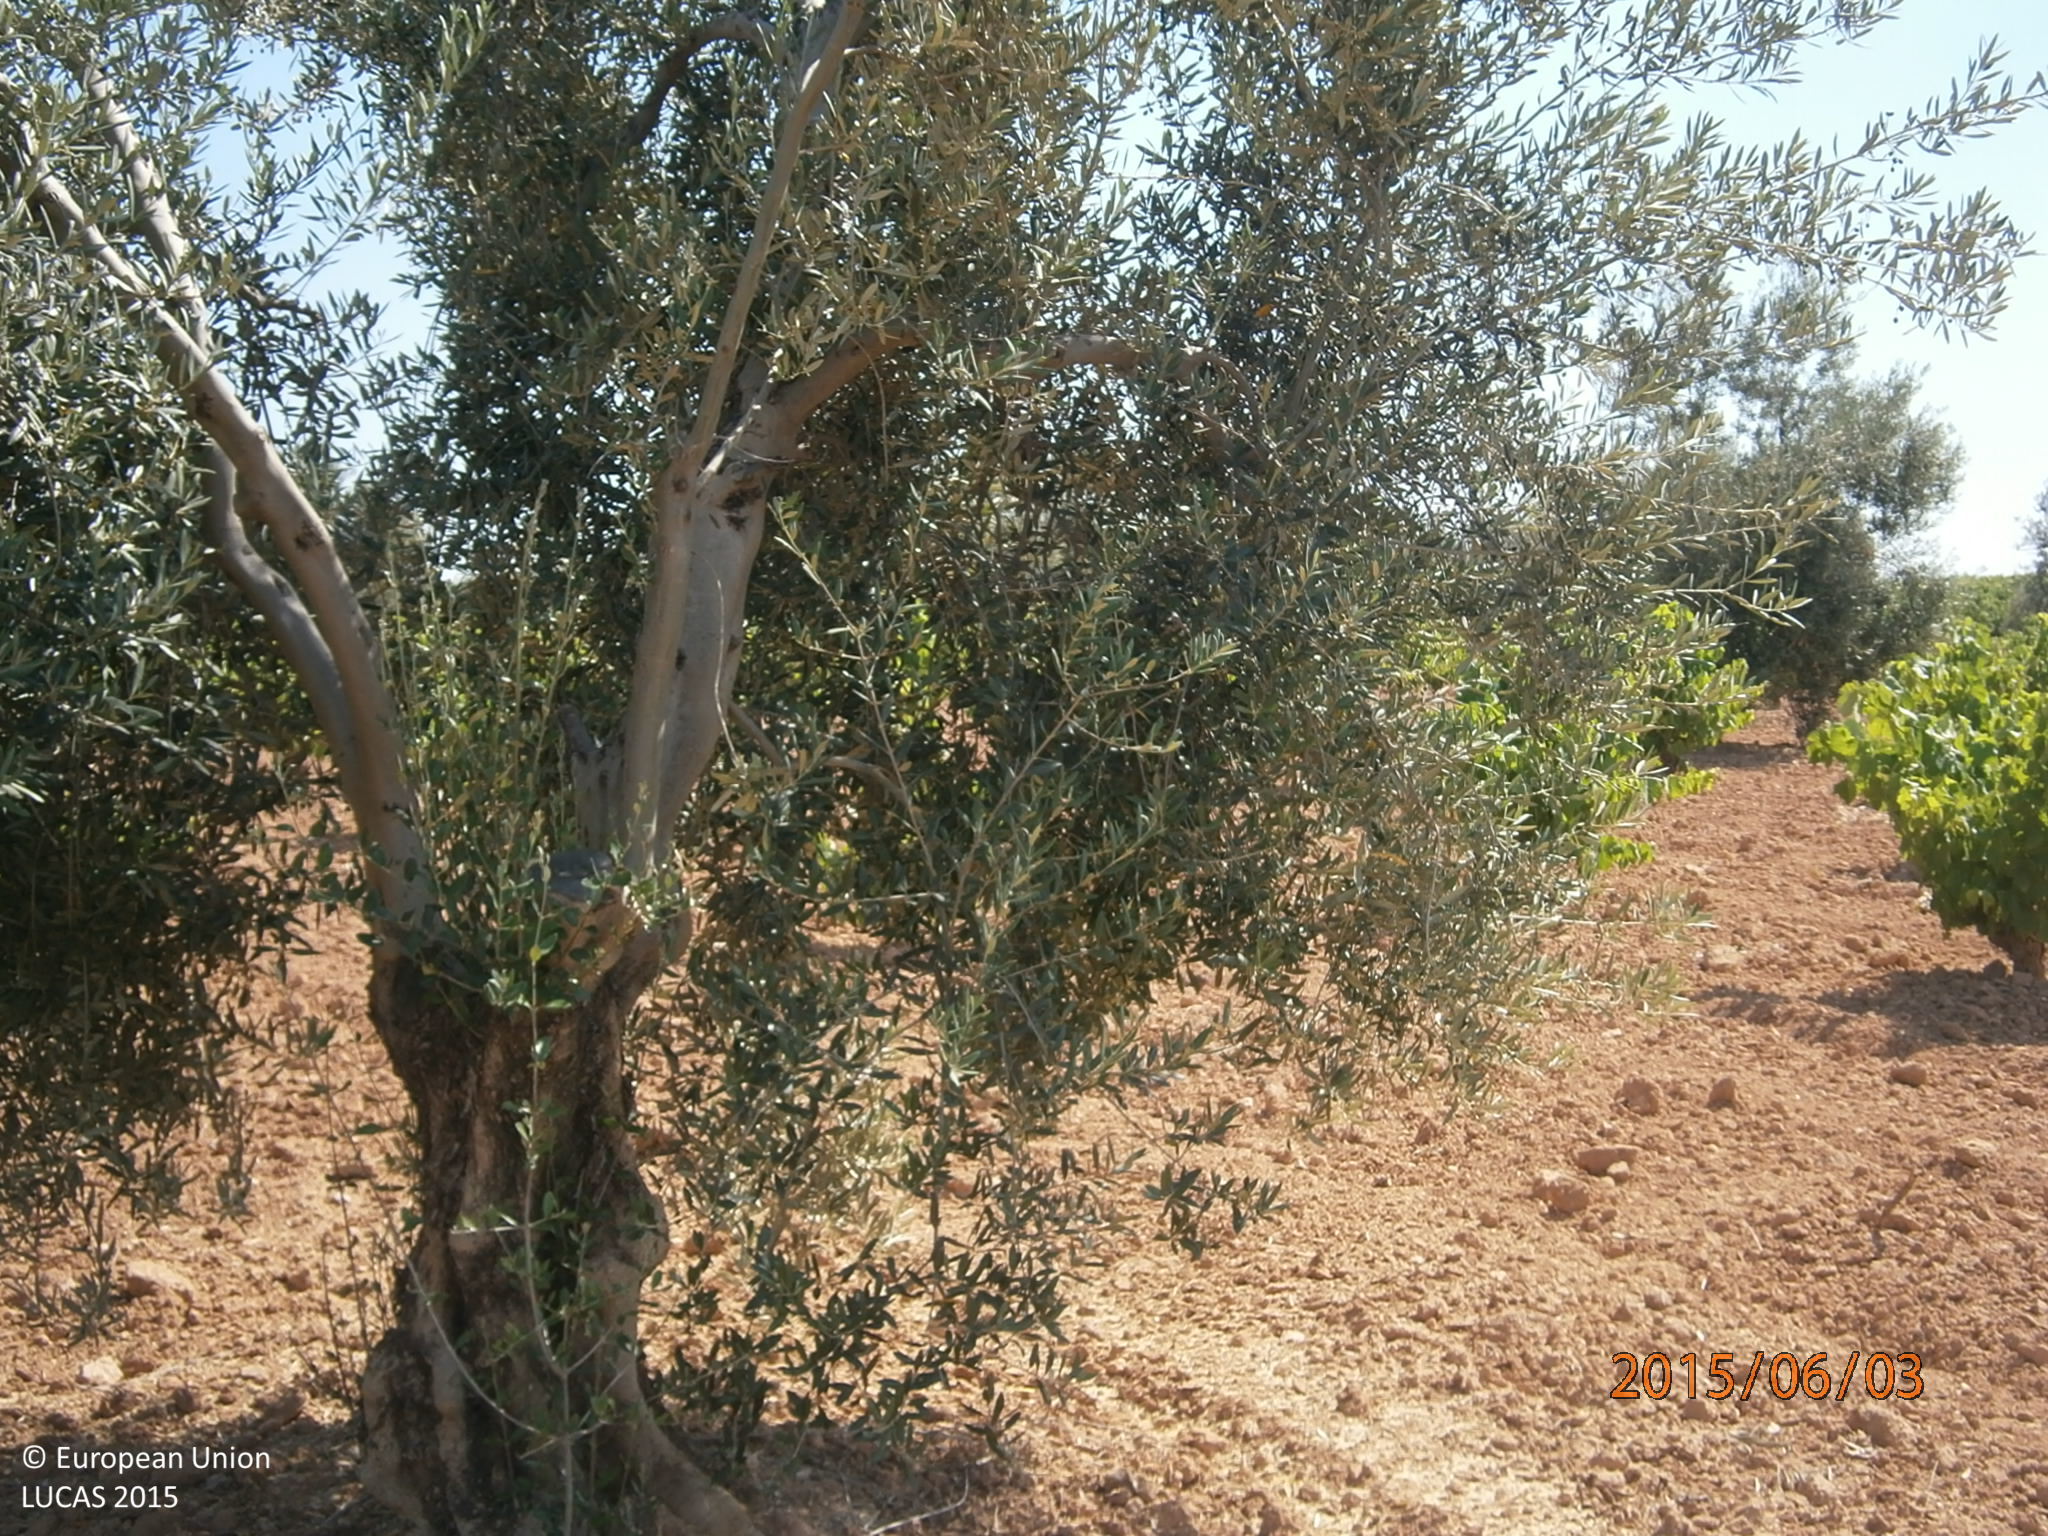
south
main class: Cropland
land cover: Olive groves
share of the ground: 10 - 25 %
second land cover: Vineyards
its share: 25 - 50 %
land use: Agriculture (excluding fallow land and kitchen gardens)
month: June
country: ES
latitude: 38.6545
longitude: -6.4060
